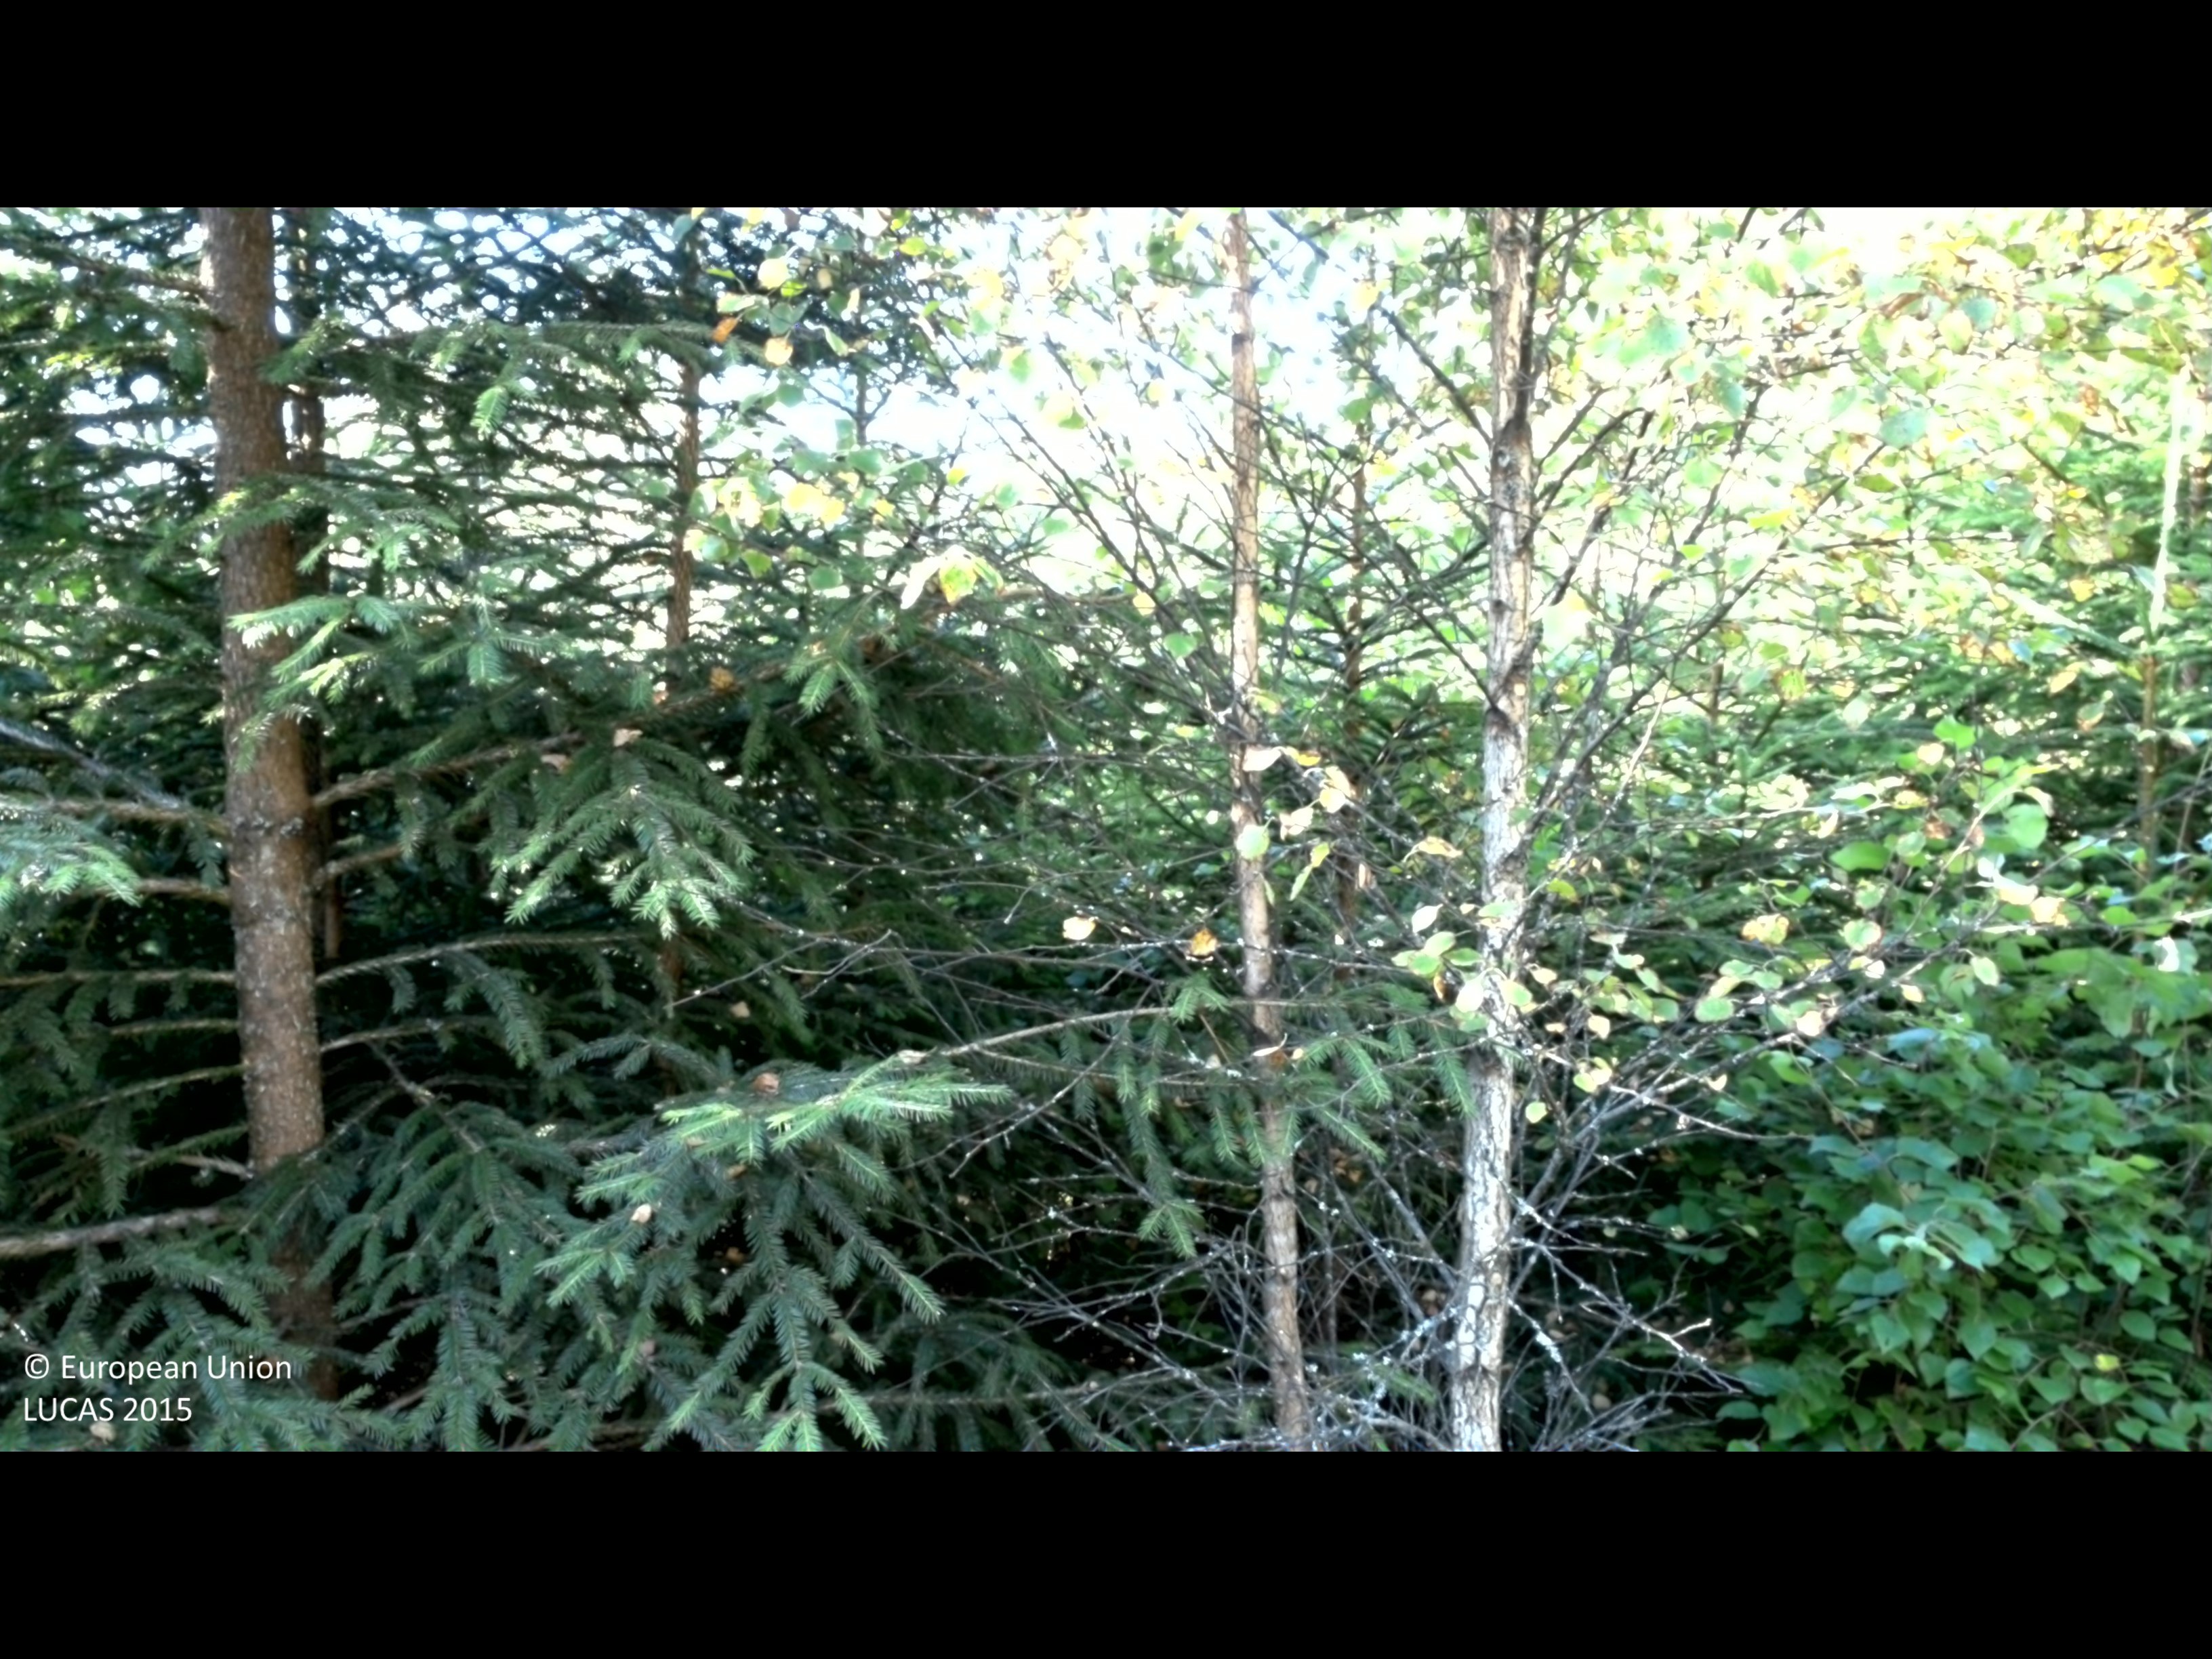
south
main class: Woodland
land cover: Spruce dominated mixed woodland
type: boreal forest
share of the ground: 50 - 75 %
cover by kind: broadleaved forest trees 40 %, coniferous forest trees 30 %, herbaceous plants 25 %, shrubs 5 %
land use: Forestry
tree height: > 5 m
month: August
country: SE
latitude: 56.9297
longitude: 14.1866
